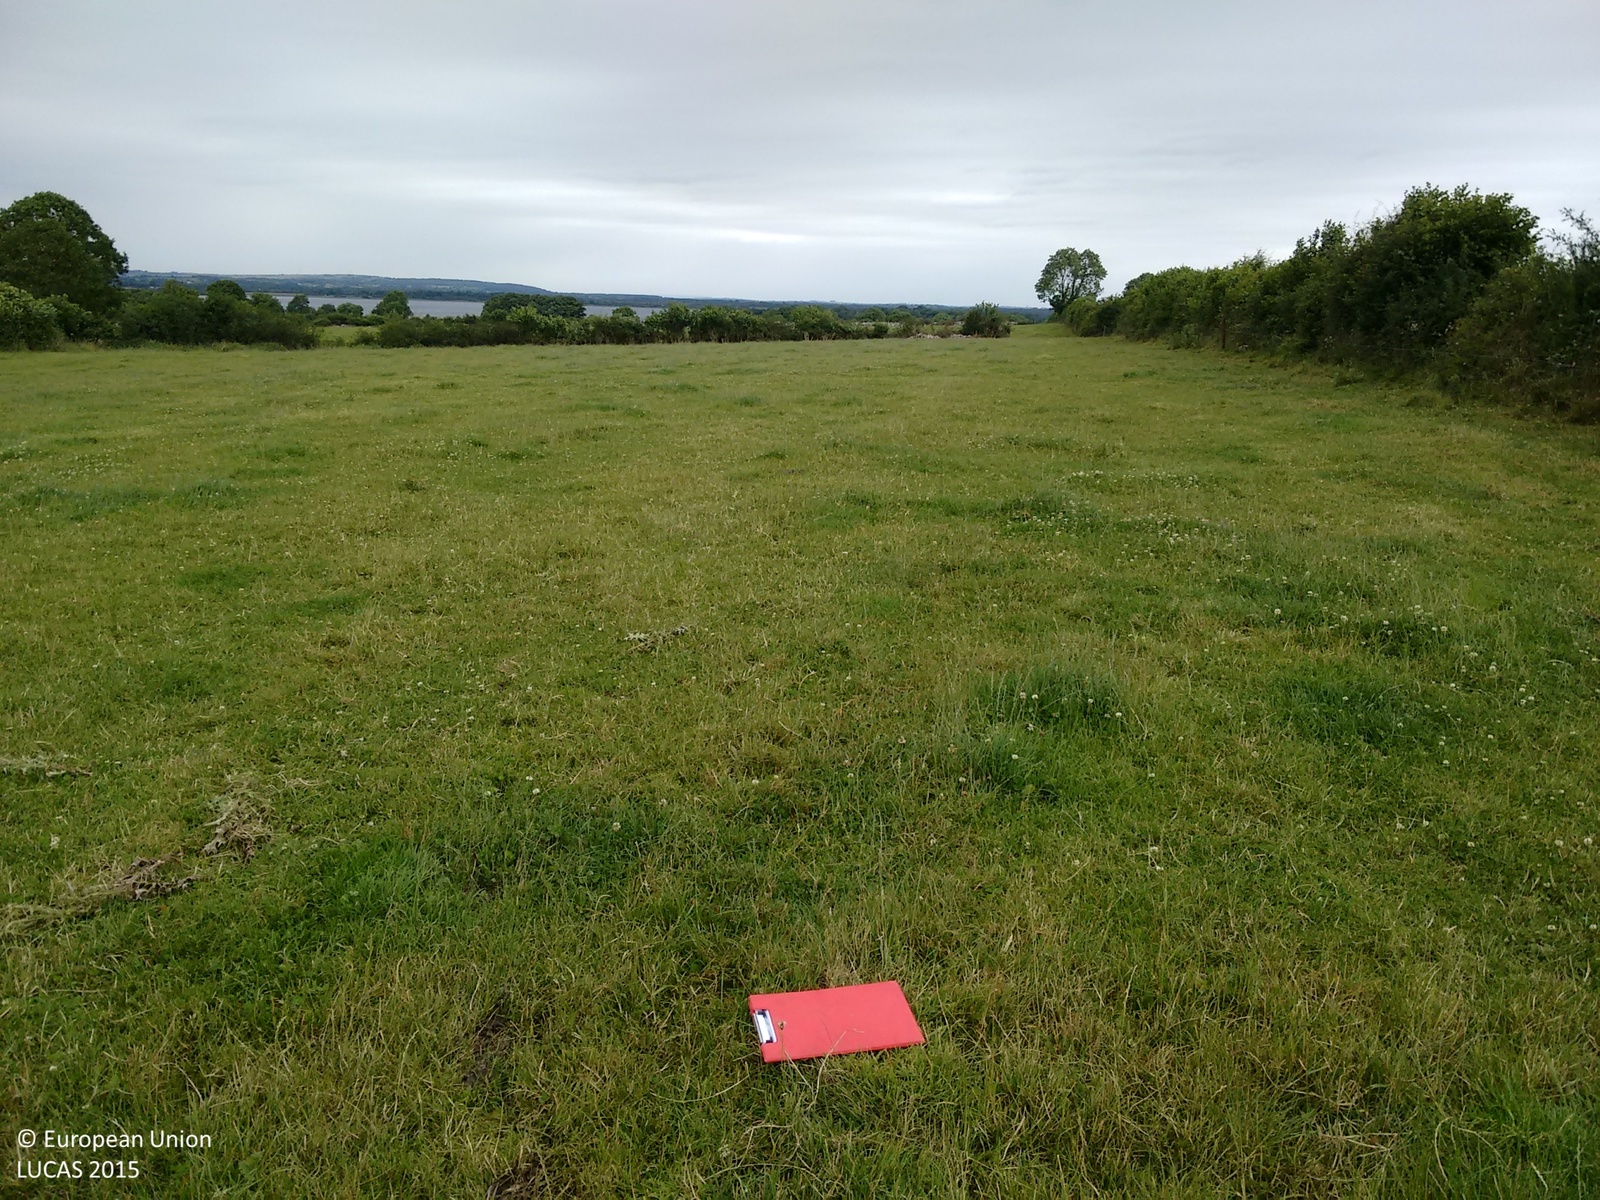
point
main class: Grassland
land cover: Grassland without tree/shrub cover
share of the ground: > 75 %
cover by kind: herbaceous plants 100 %
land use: Agriculture (excluding fallow land and kitchen gardens)
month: July
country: IE
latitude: 53.6234
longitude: -8.0008
